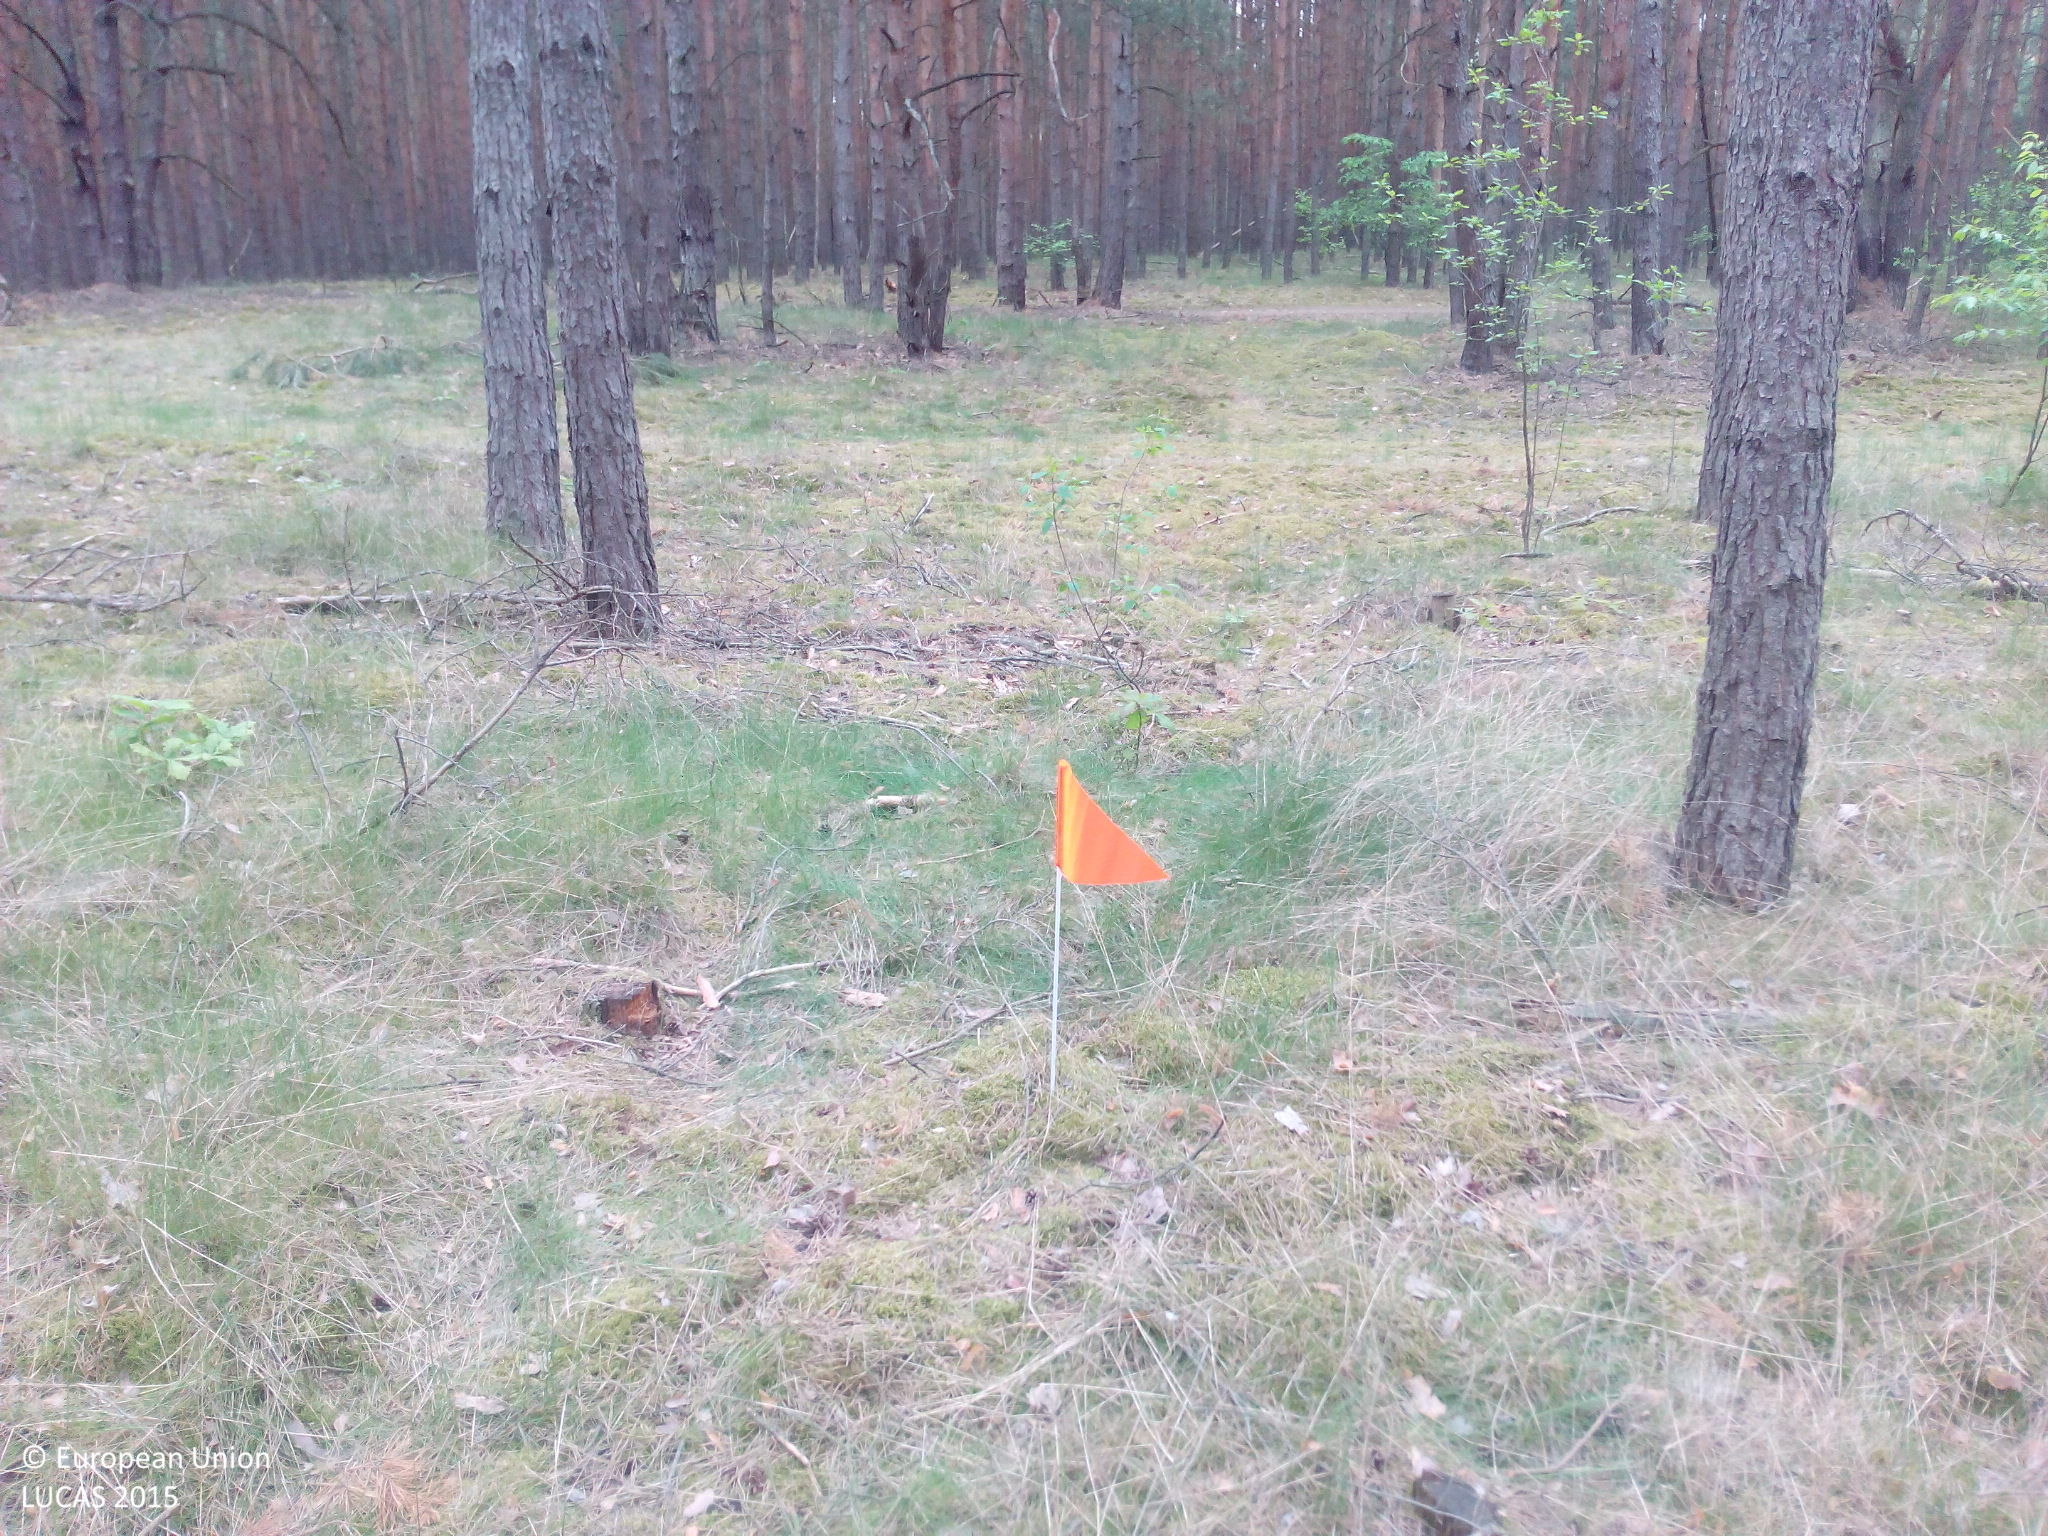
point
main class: Woodland
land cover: Pine dominated coniferous woodland
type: hemiboreal forest and nemoral coniferous forest and mixed broadleaved-coniferous forest
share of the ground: > 75 %
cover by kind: coniferous forest trees 75 %, lichens and mosses 20 %, herbaceous plants 5 %
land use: Forestry
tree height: > 5 m
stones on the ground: < 10 %
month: May
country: DE
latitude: 52.2271
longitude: 13.1769
